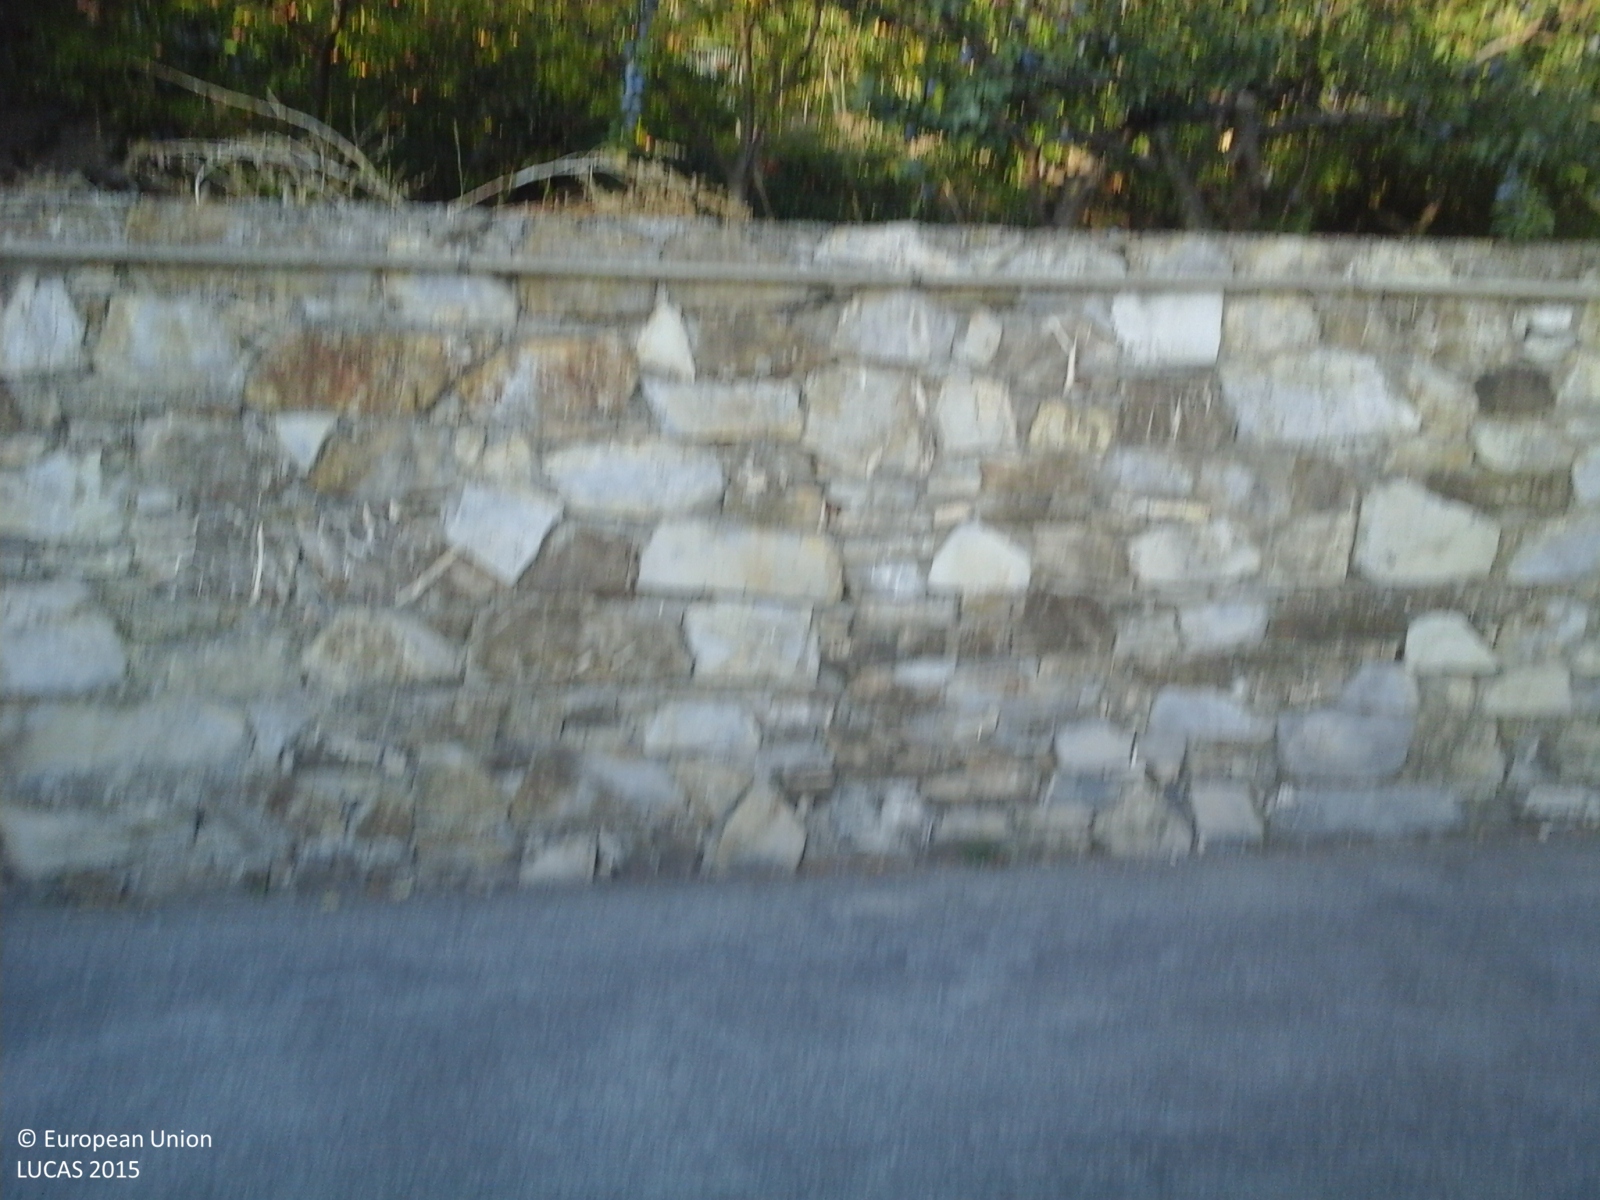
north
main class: Grassland
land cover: Grassland without tree/shrub cover
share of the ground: > 75 %
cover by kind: herbaceous plants 90 %, shrubs 5 %, consolidated bare surface 5 %
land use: Residential
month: August
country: IT
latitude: 44.3472
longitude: 9.1615
